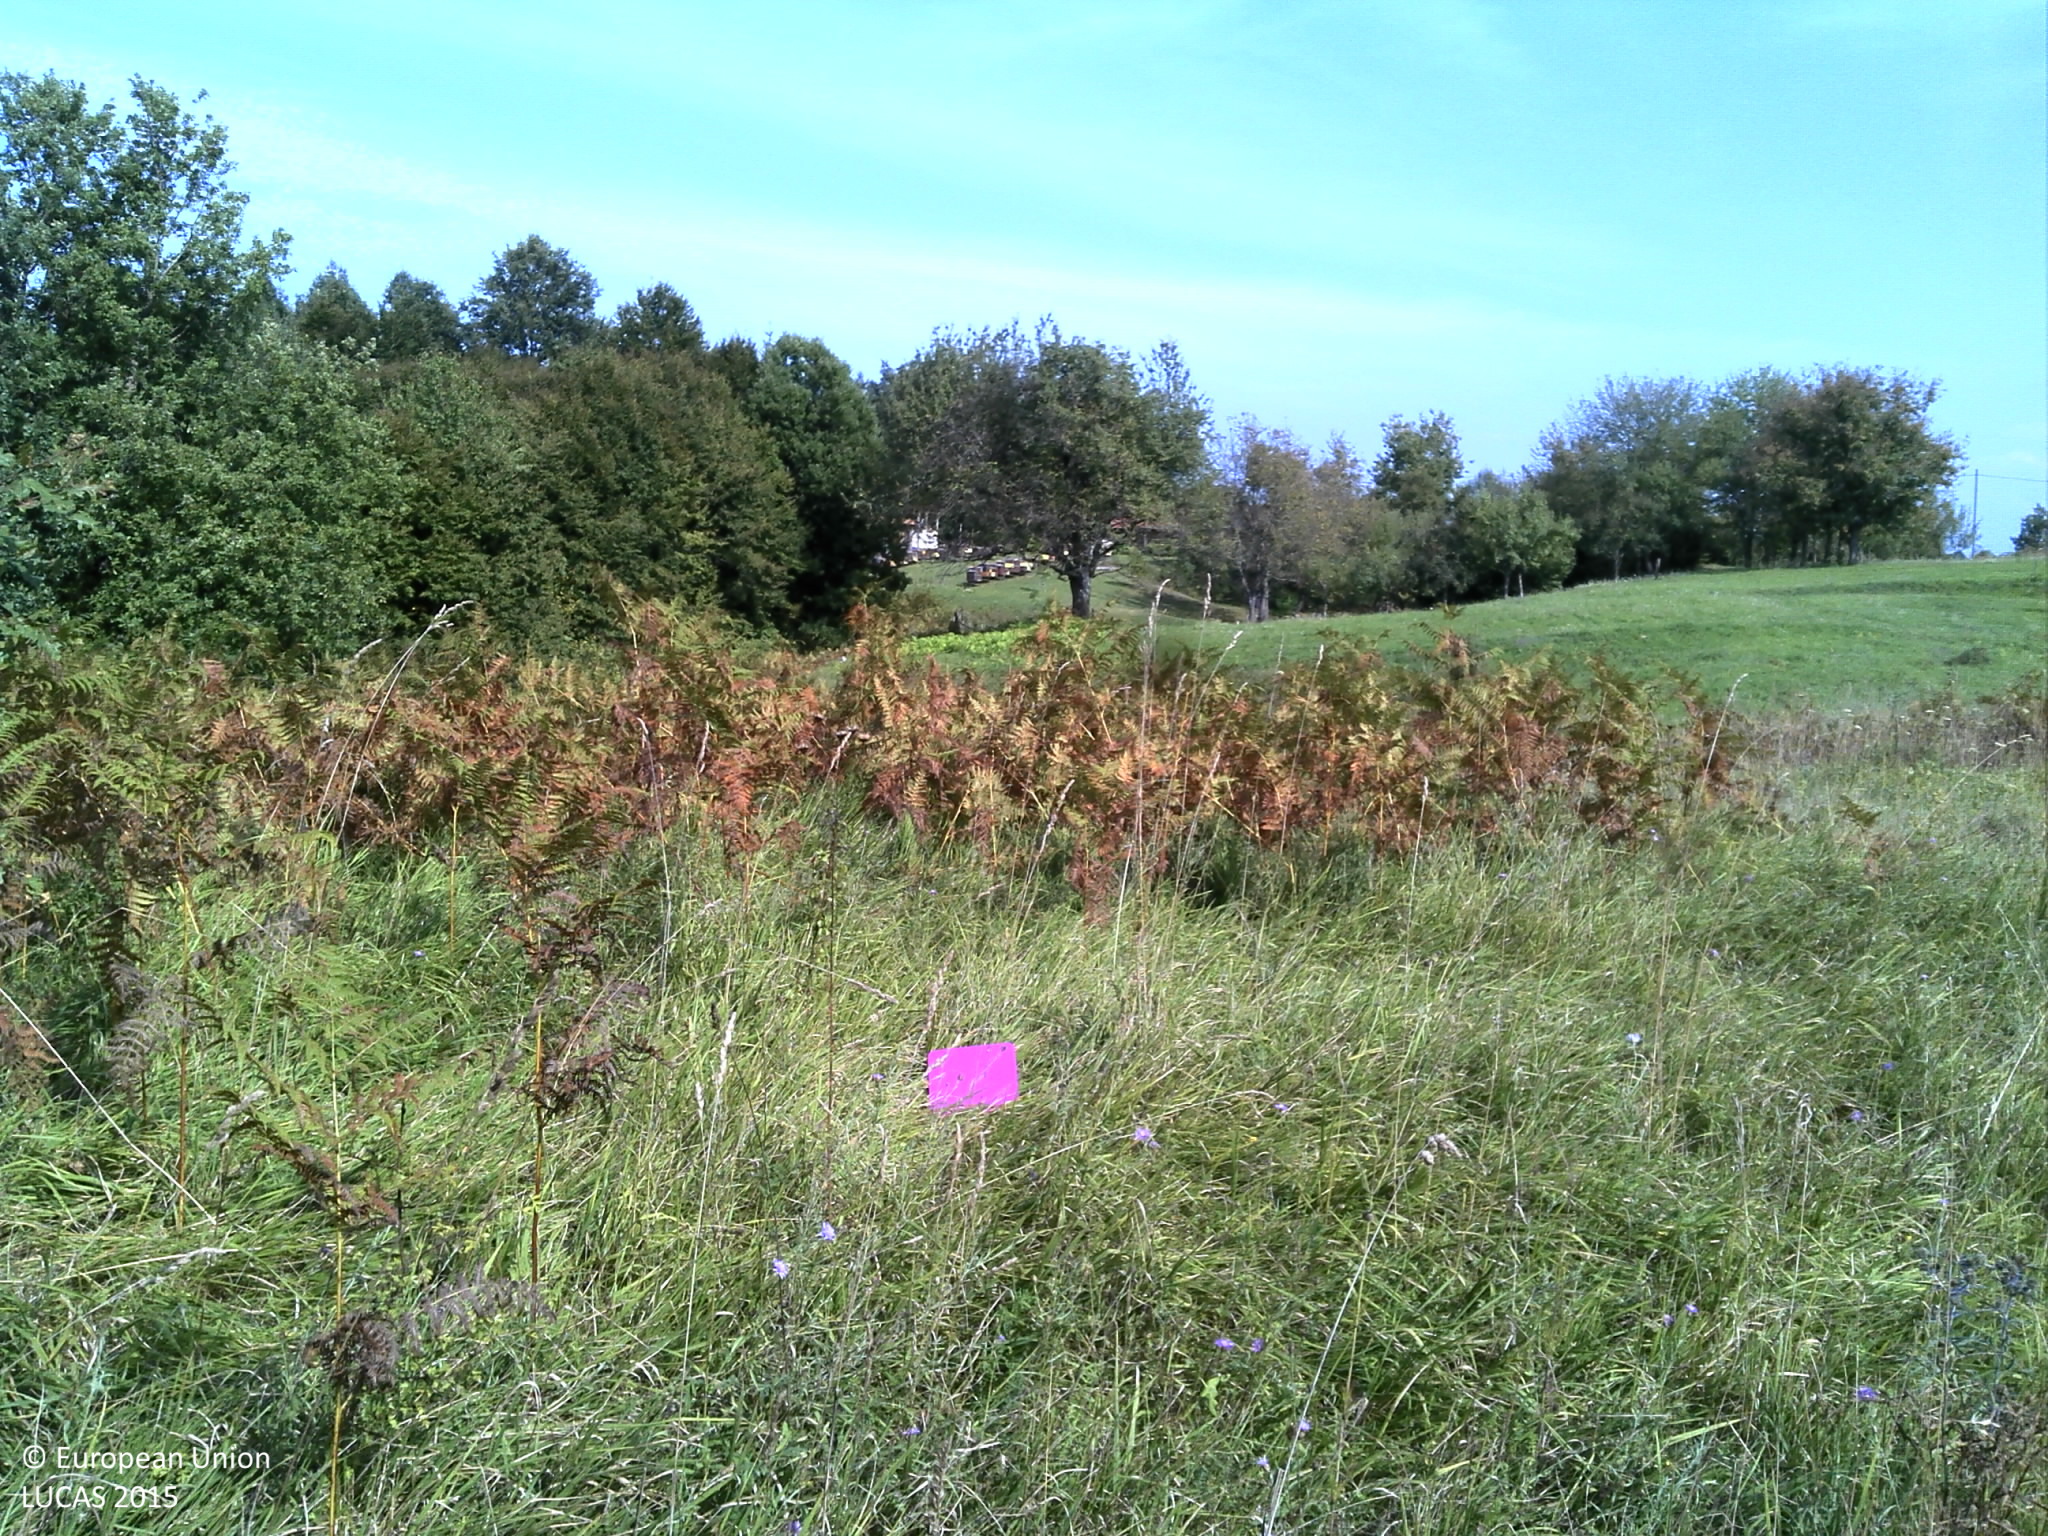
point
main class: Grassland
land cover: Grassland with sparse tree/shrub cover
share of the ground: > 75 %
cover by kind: herbaceous plants 95 %, broadleaved forest trees 5 %
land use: Semi-natural and natural areas not in use
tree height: < 5 m
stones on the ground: < 10 %
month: September
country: HR
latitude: 45.0988
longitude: 15.6757
